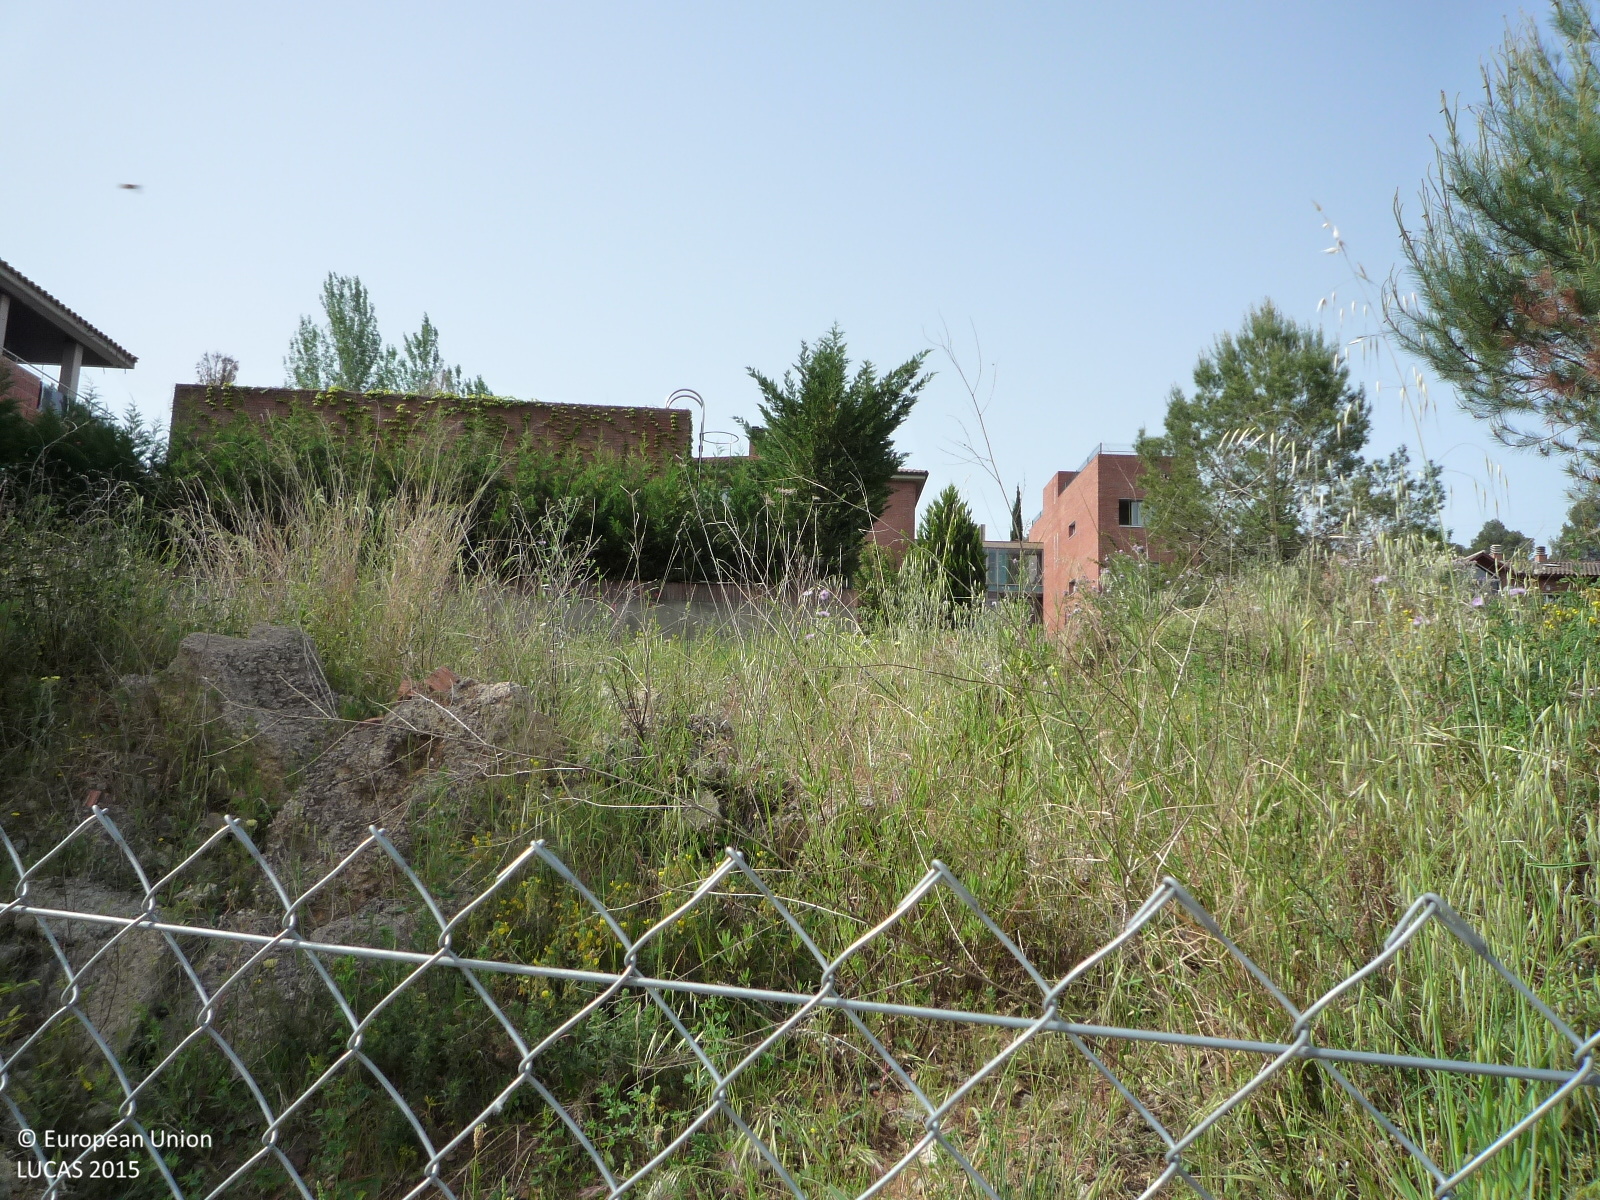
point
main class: Grassland
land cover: Grassland with sparse tree/shrub cover
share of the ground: > 75 %
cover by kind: herbaceous plants 95 %, coniferous forest trees 5 %
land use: Abandoned areas
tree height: < 5 m
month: May
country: ES
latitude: 41.4545
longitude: 2.0807
